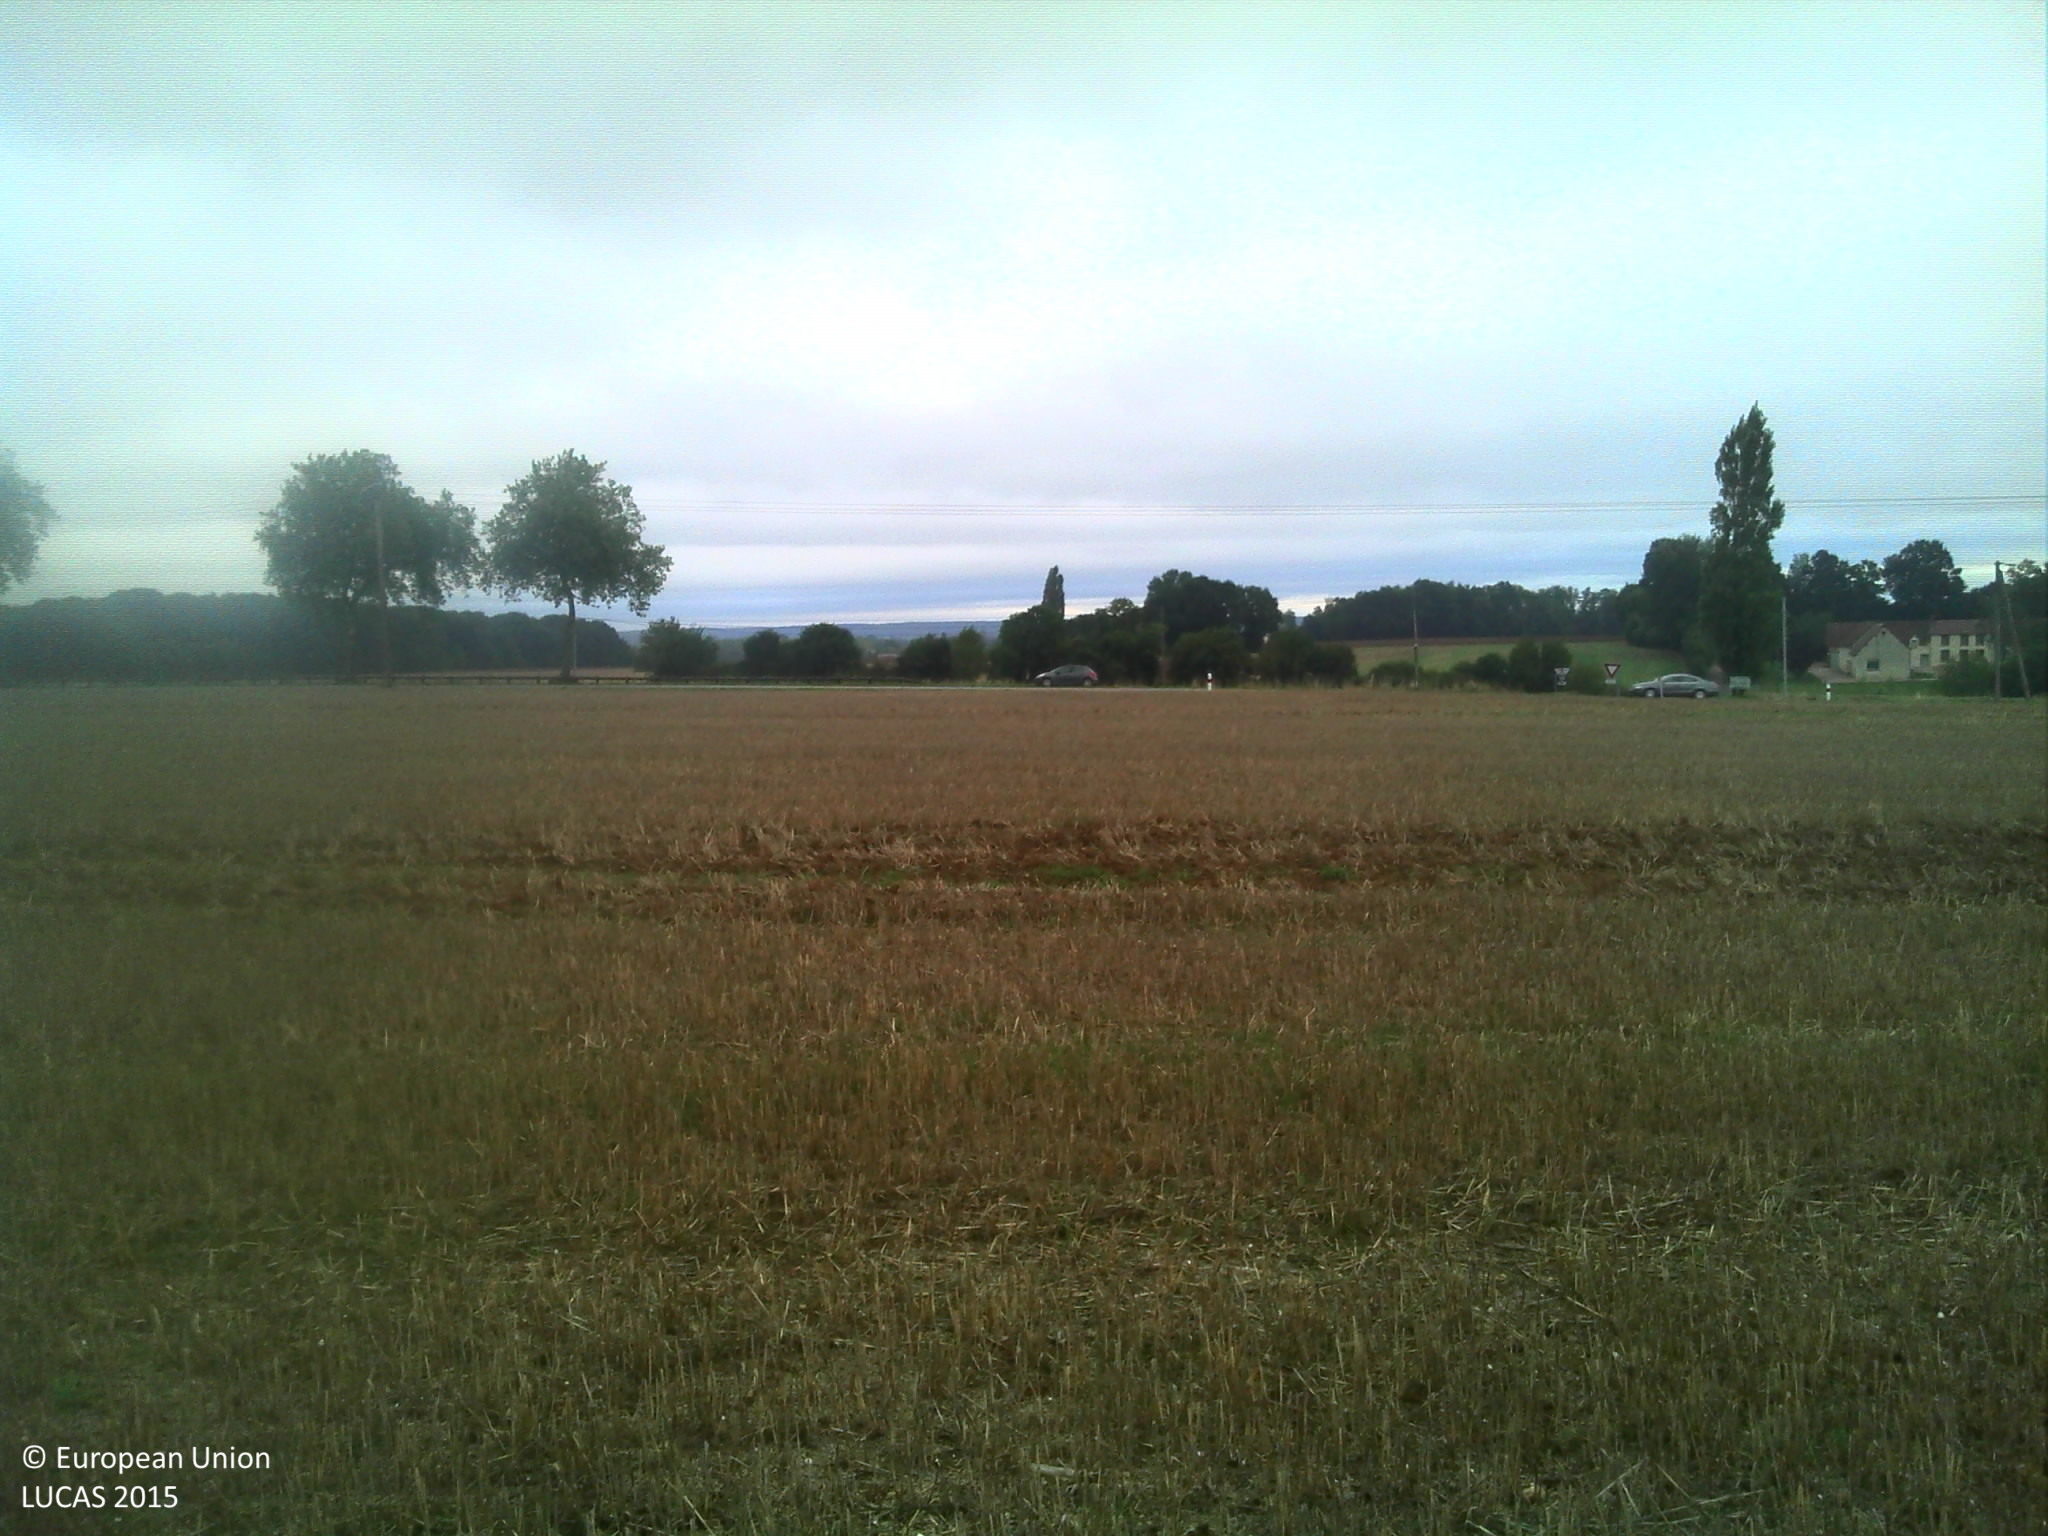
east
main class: Cropland
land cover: Common wheat
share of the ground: < 10 %
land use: Agriculture (excluding fallow land and kitchen gardens)
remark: Harvested field
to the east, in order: Common wheat; Electric lines; Ditches and canals; Grass margins; Paved roads, cycling and walking lanes; Grass margins; Ditches and canals; Electric lines; Common wheat
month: August
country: FR
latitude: 48.4866
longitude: 0.5451
